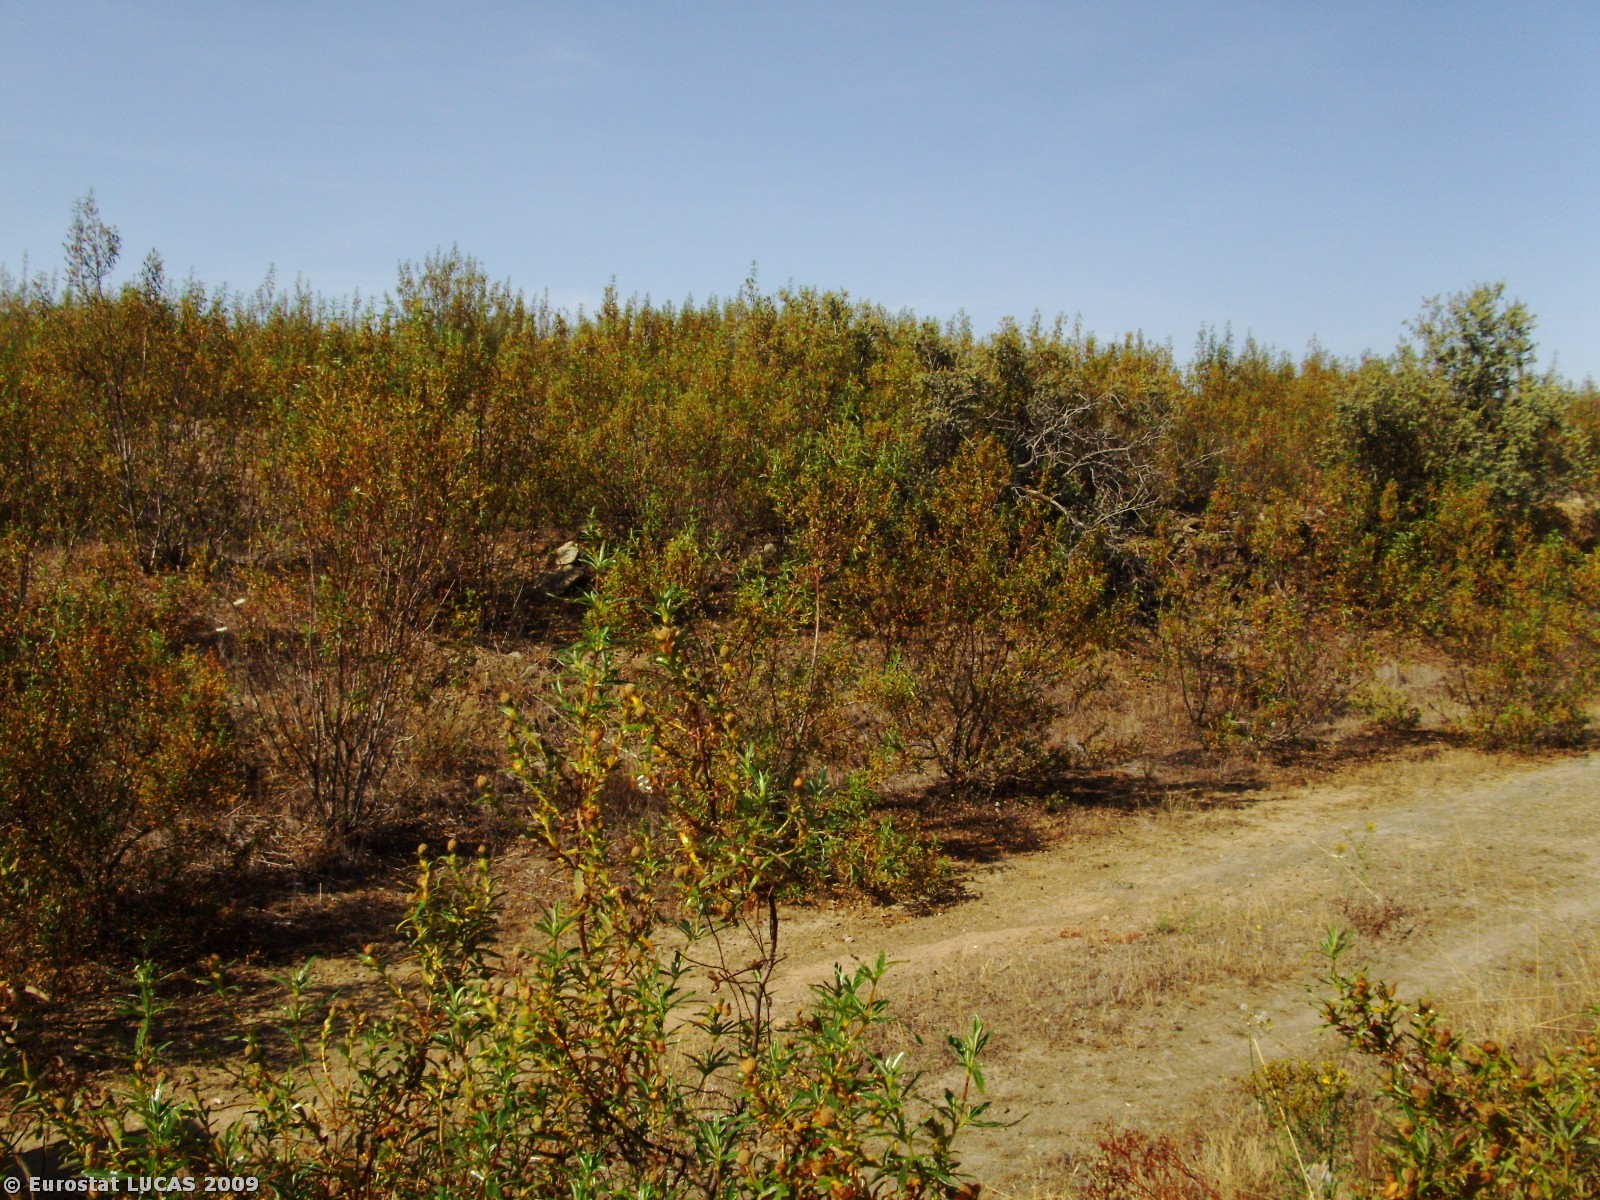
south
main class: Shrubland
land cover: Shrubland with sparse tree cover
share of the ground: > 75 %
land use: Unused
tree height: > 5 m
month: June
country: PT
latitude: 39.9848
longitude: -7.2282
